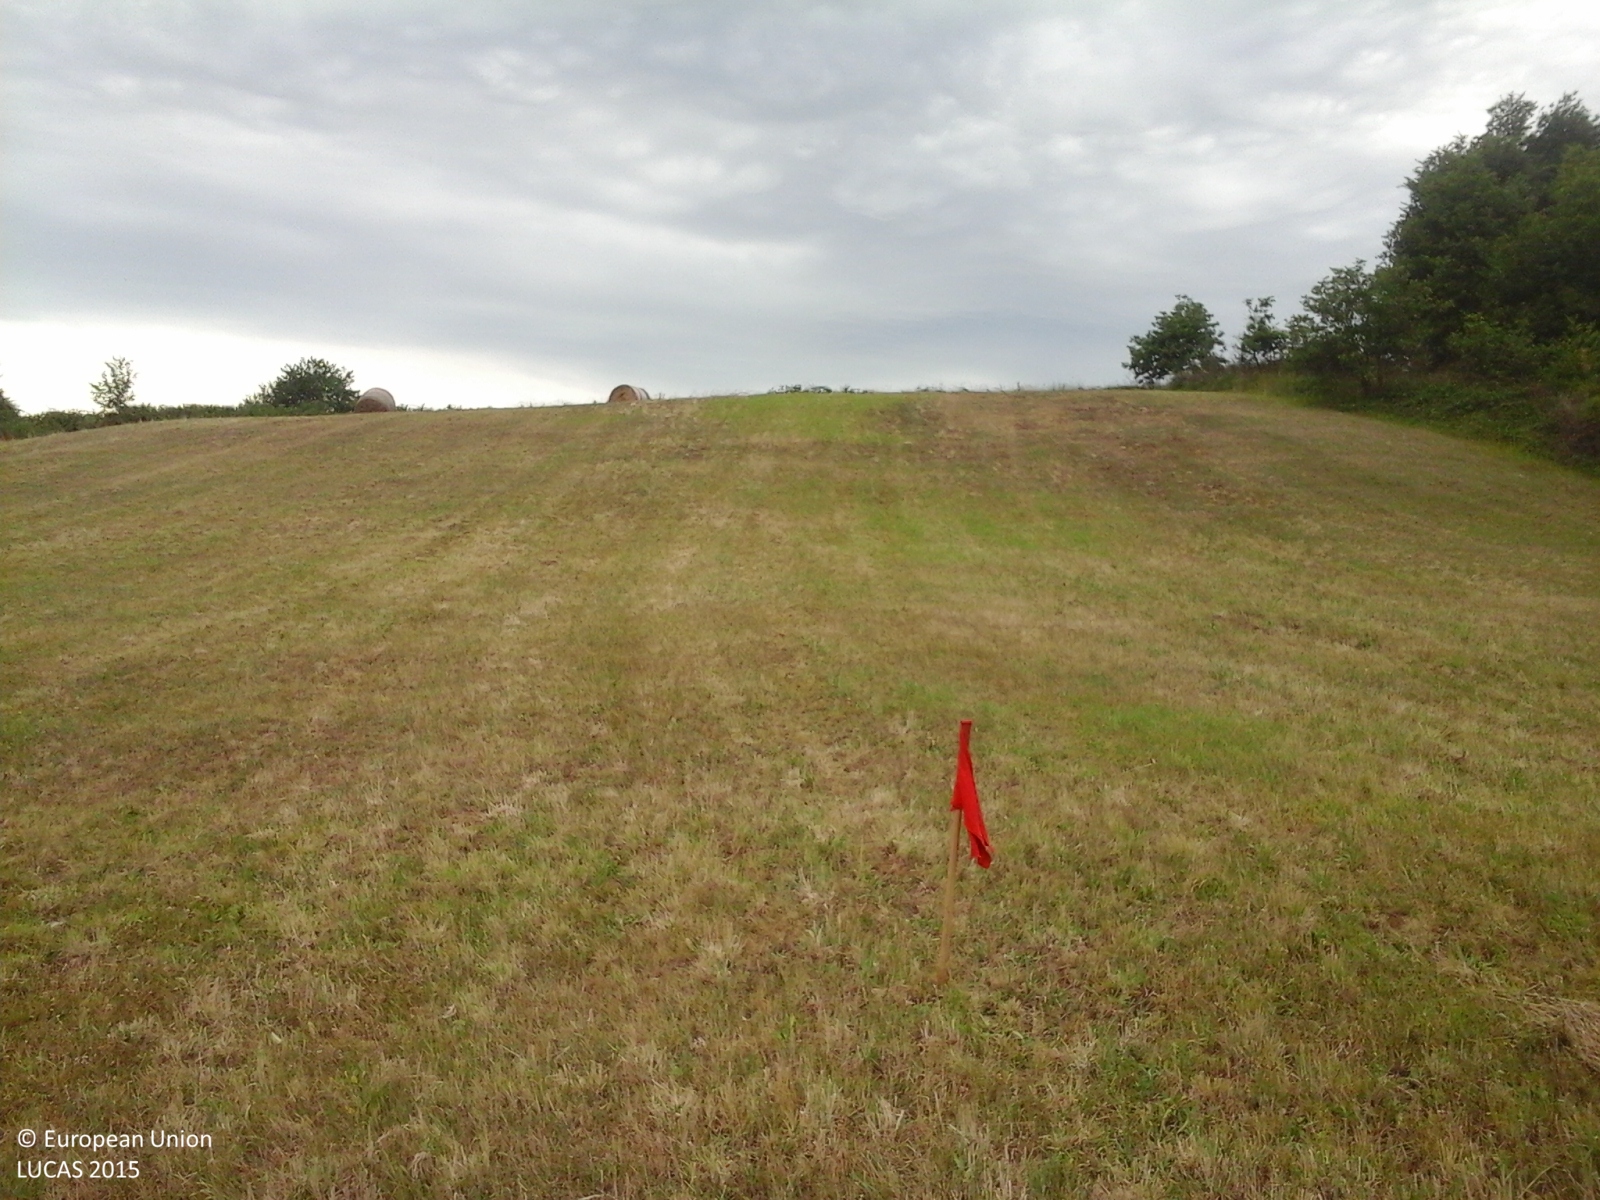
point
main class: Grassland
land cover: Spontaneously vegetated surfaces
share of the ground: > 75 %
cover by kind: herbaceous plants 100 %
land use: Agriculture (excluding fallow land and kitchen gardens)
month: June
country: IT
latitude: 41.7936
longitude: 13.0813
